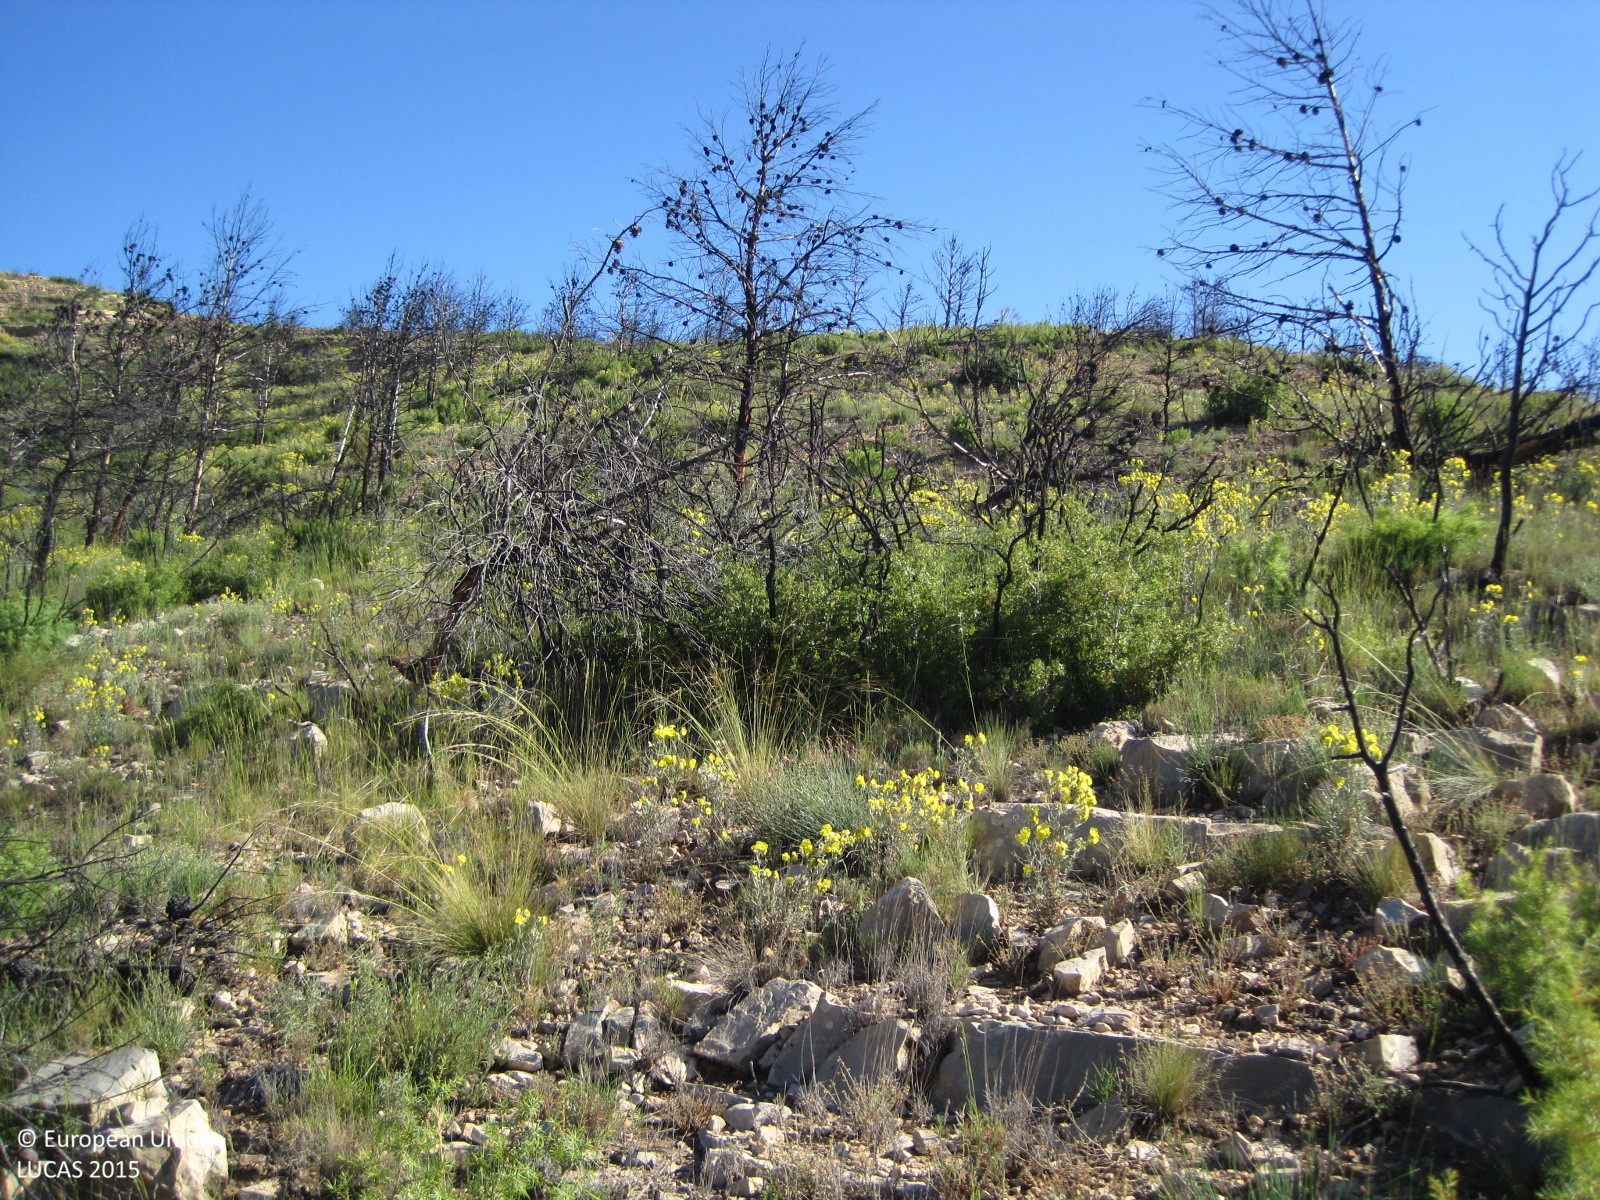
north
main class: Shrubland
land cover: Shrubland with sparse tree cover
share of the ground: 25 - 50 %
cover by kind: shrubs 40 %, herbaceous plants 35 %, consolidated bare surface 20 %, coniferous forest trees 5 %
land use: Semi-natural and natural areas not in use
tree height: < 5 m
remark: Burnt area
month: May
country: ES
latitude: 39.7708
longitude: -0.7075
